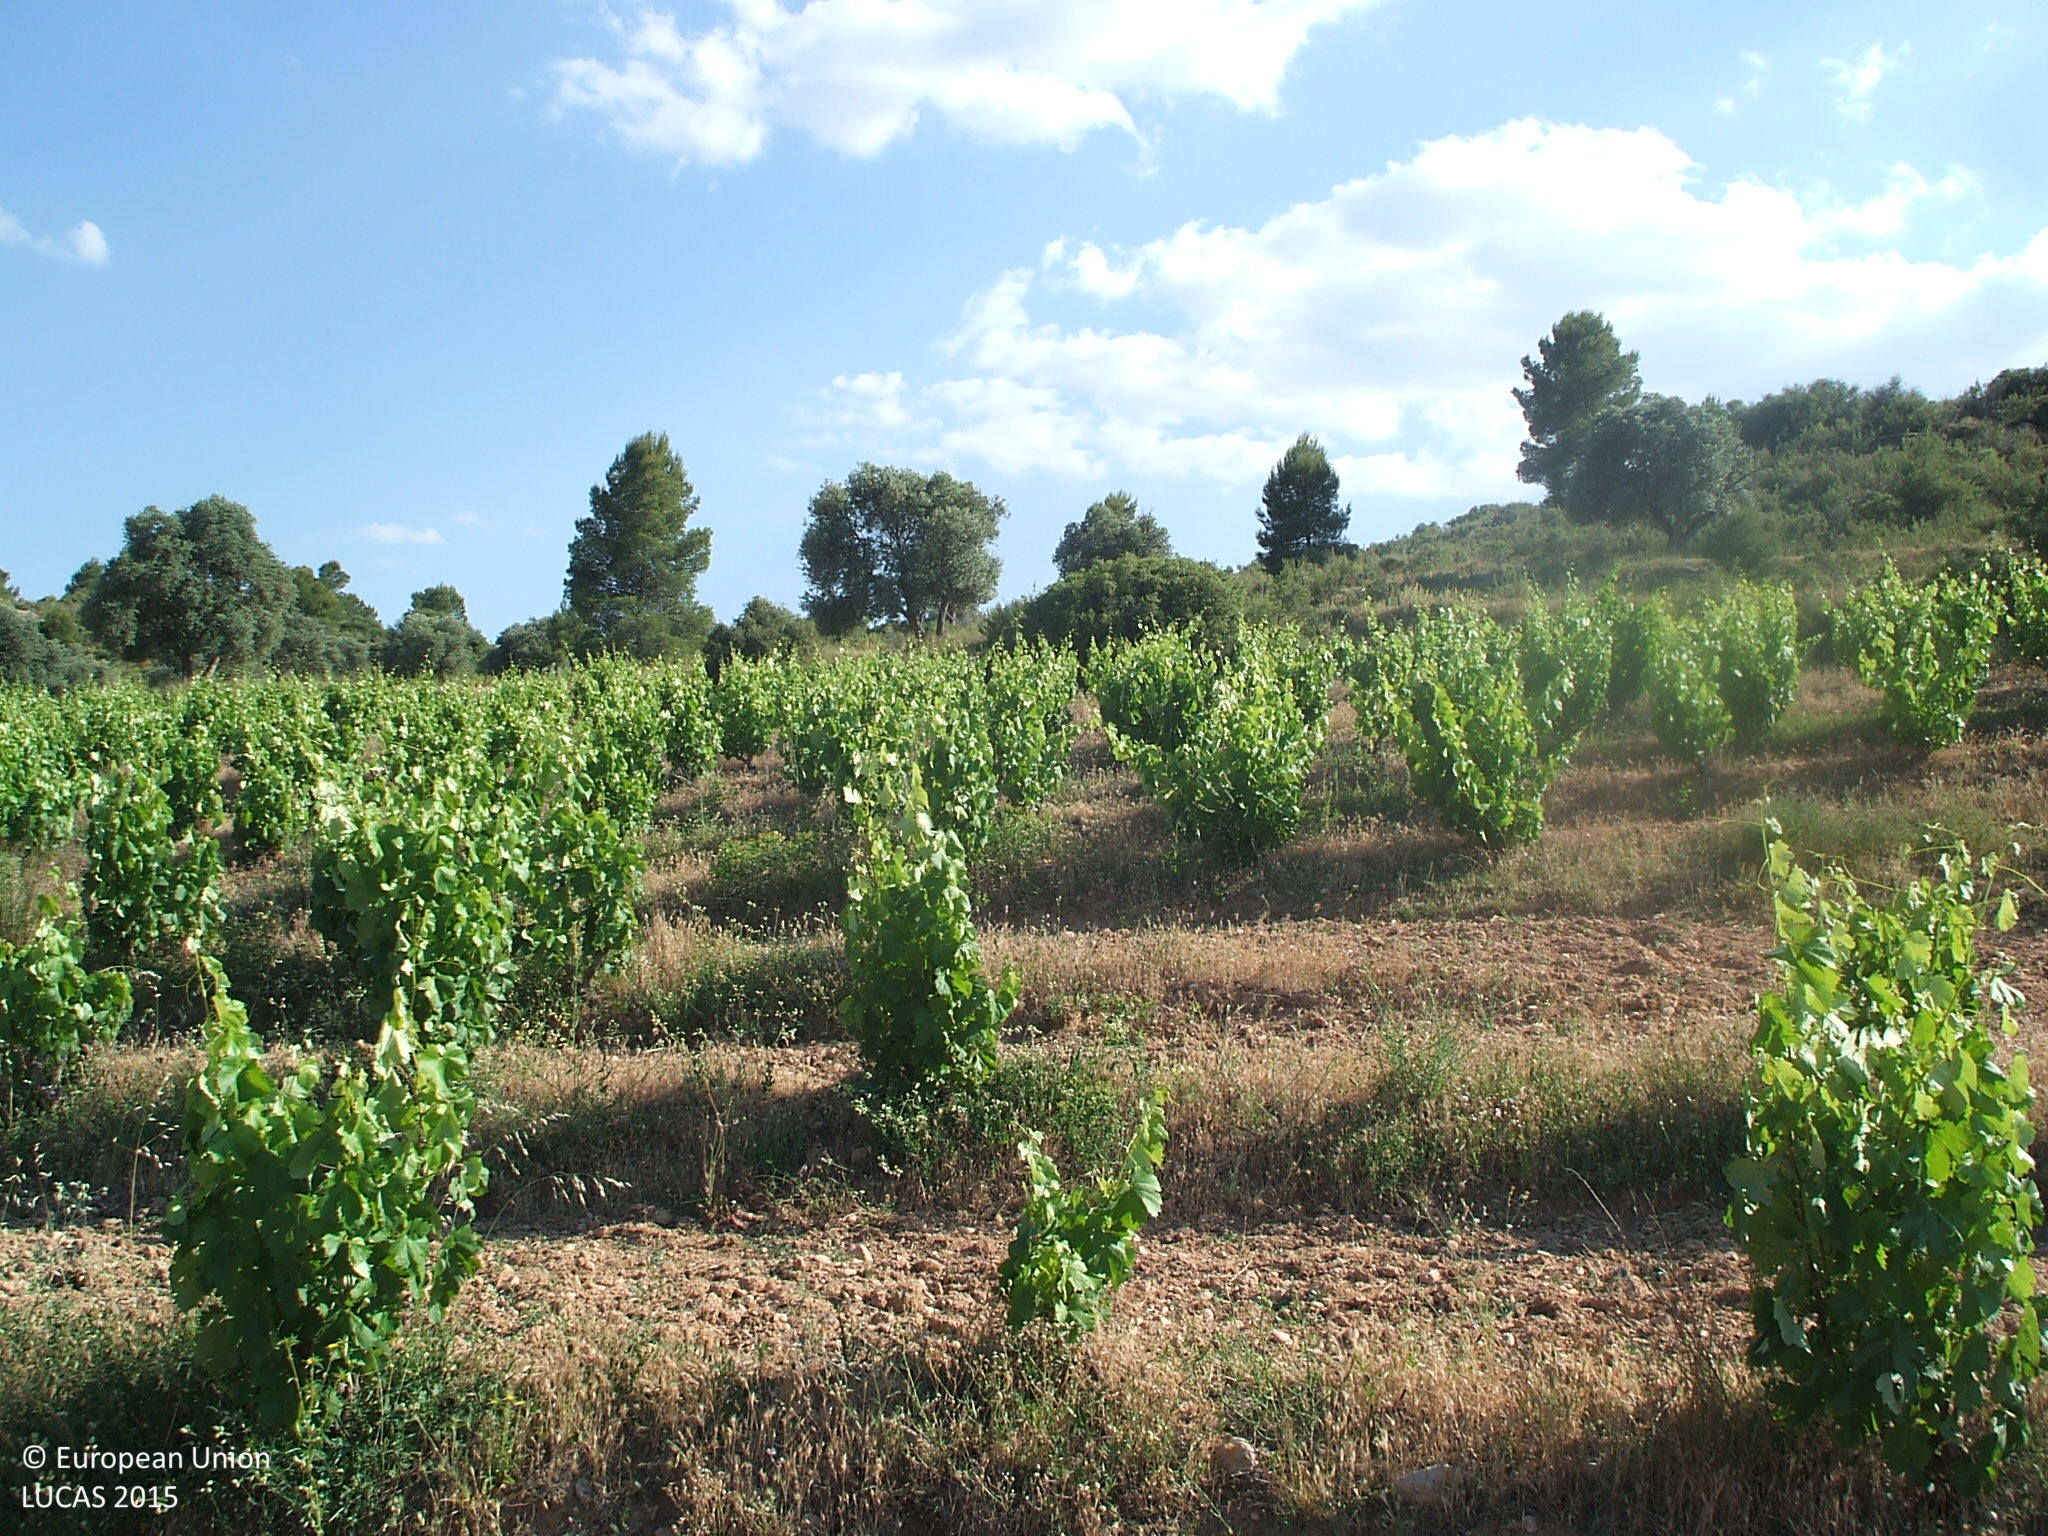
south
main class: Cropland
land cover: Vineyards
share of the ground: 10 - 25 %
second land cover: Other bare soil
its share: > 75 %
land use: Agriculture (excluding fallow land and kitchen gardens)
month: June
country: ES
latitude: 40.9808
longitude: -0.1249
